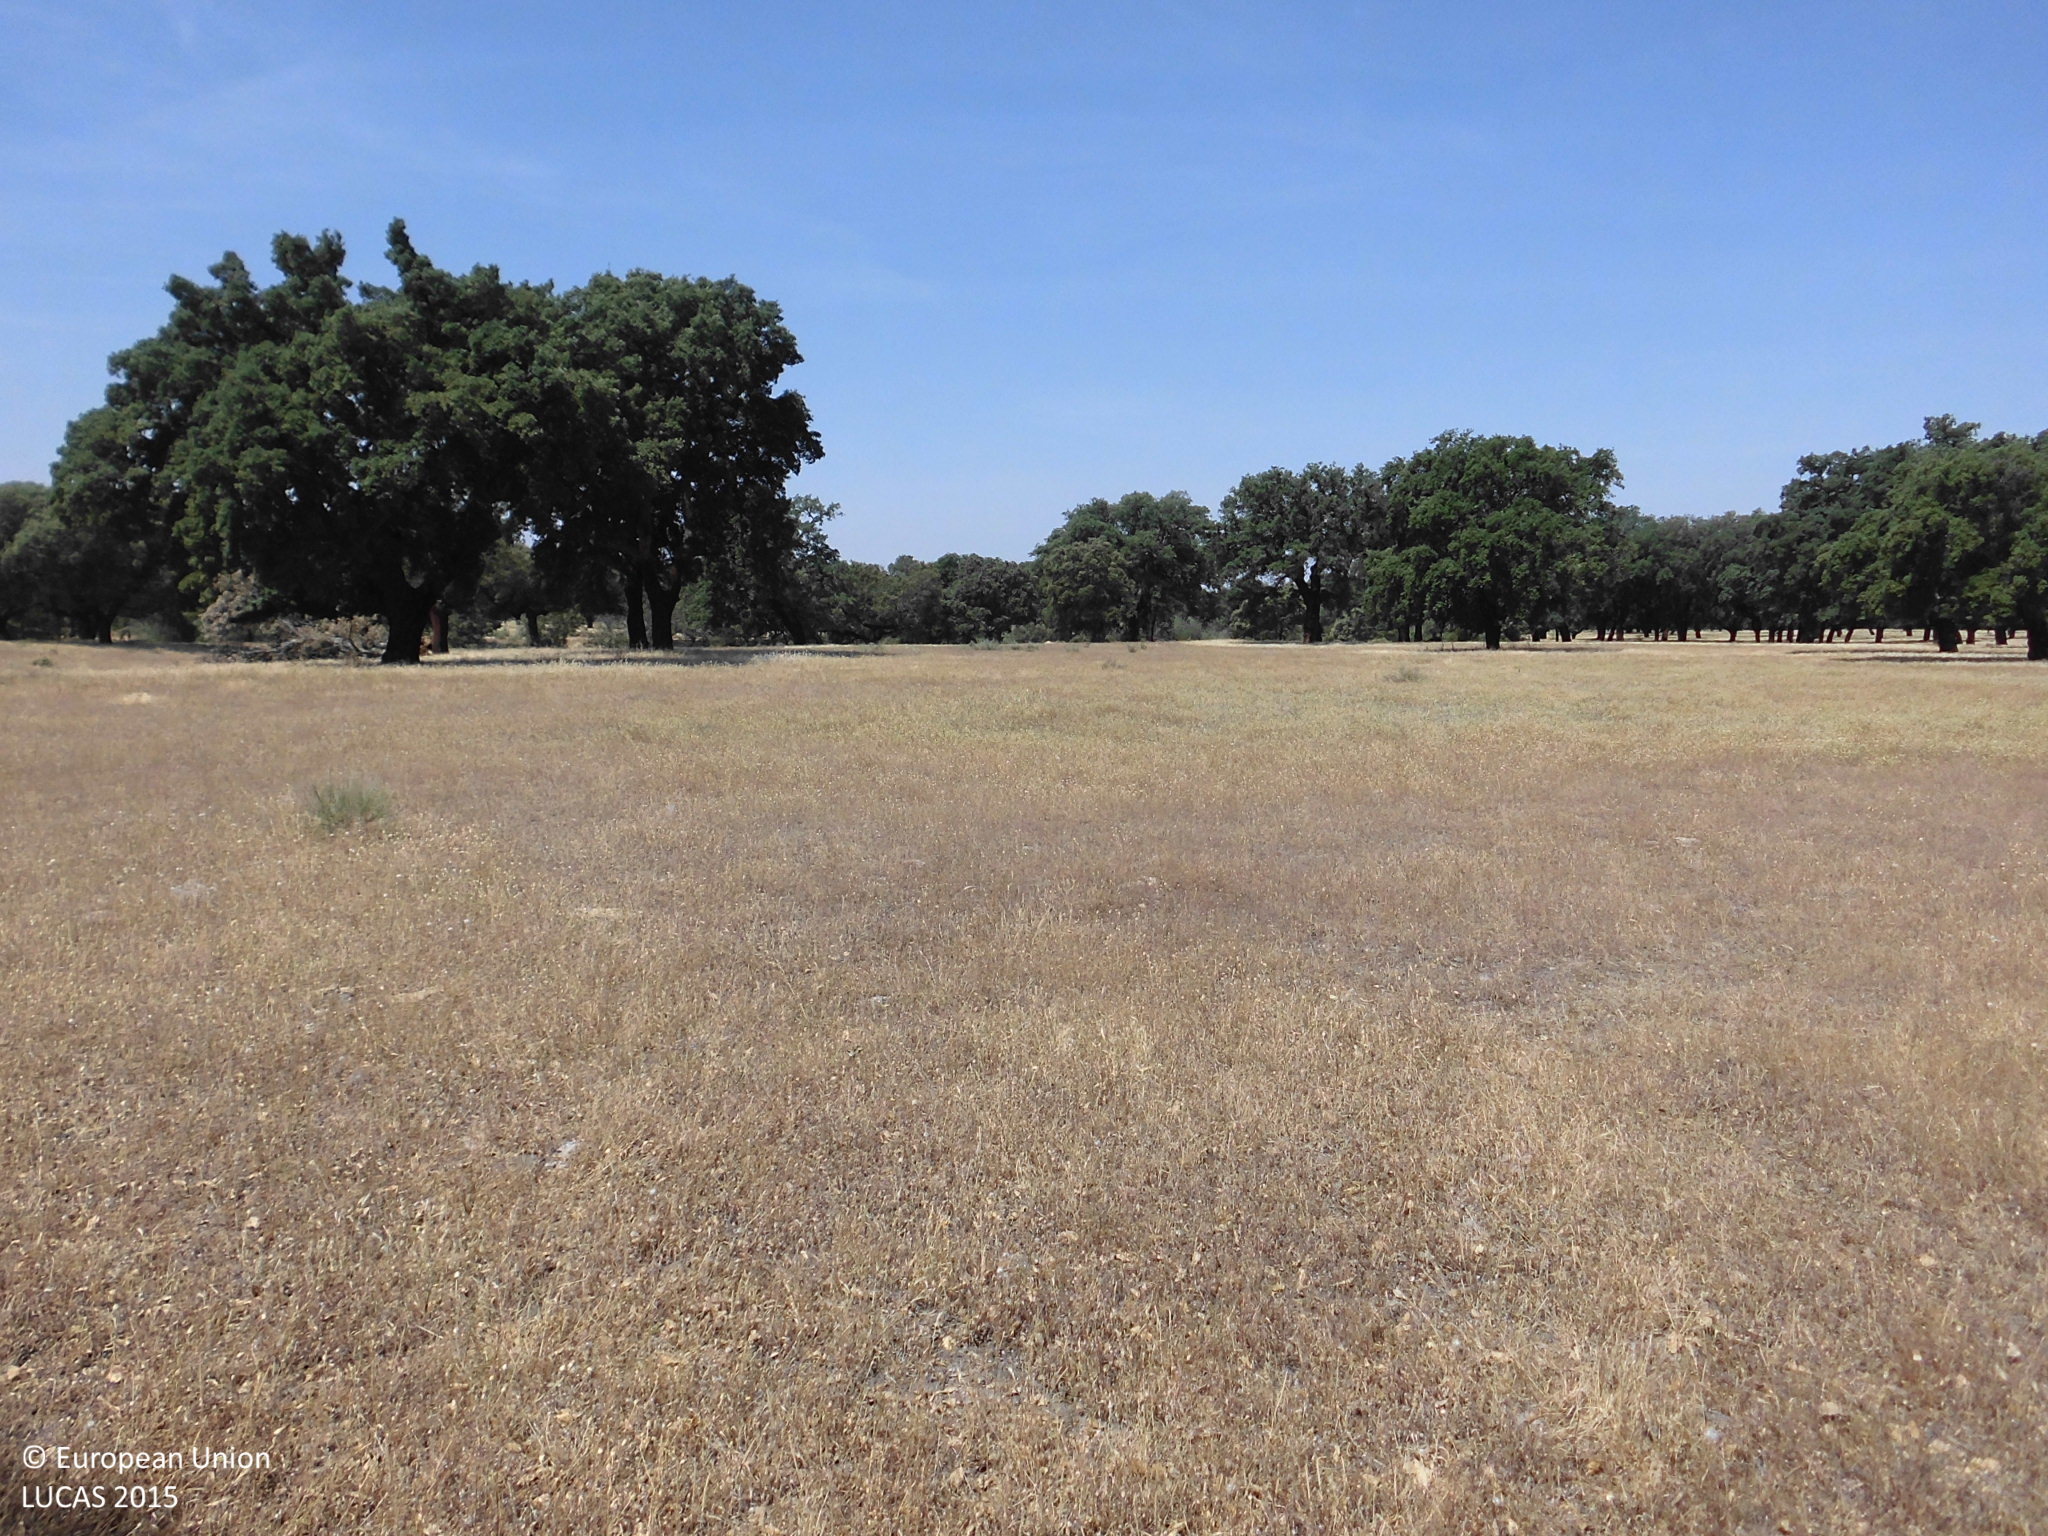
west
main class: Woodland
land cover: Broadleaved woodland
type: broadleaved evergreen forest
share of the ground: 25 - 50 %
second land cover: Grassland without tree/shrub cover
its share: > 75 %
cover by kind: herbaceous plants 75 %, broadleaved forest trees 25 %
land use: Forestry
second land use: Agriculture (excluding fallow land and kitchen gardens)
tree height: > 5 m
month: June
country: ES
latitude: 39.9364
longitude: -5.4465
